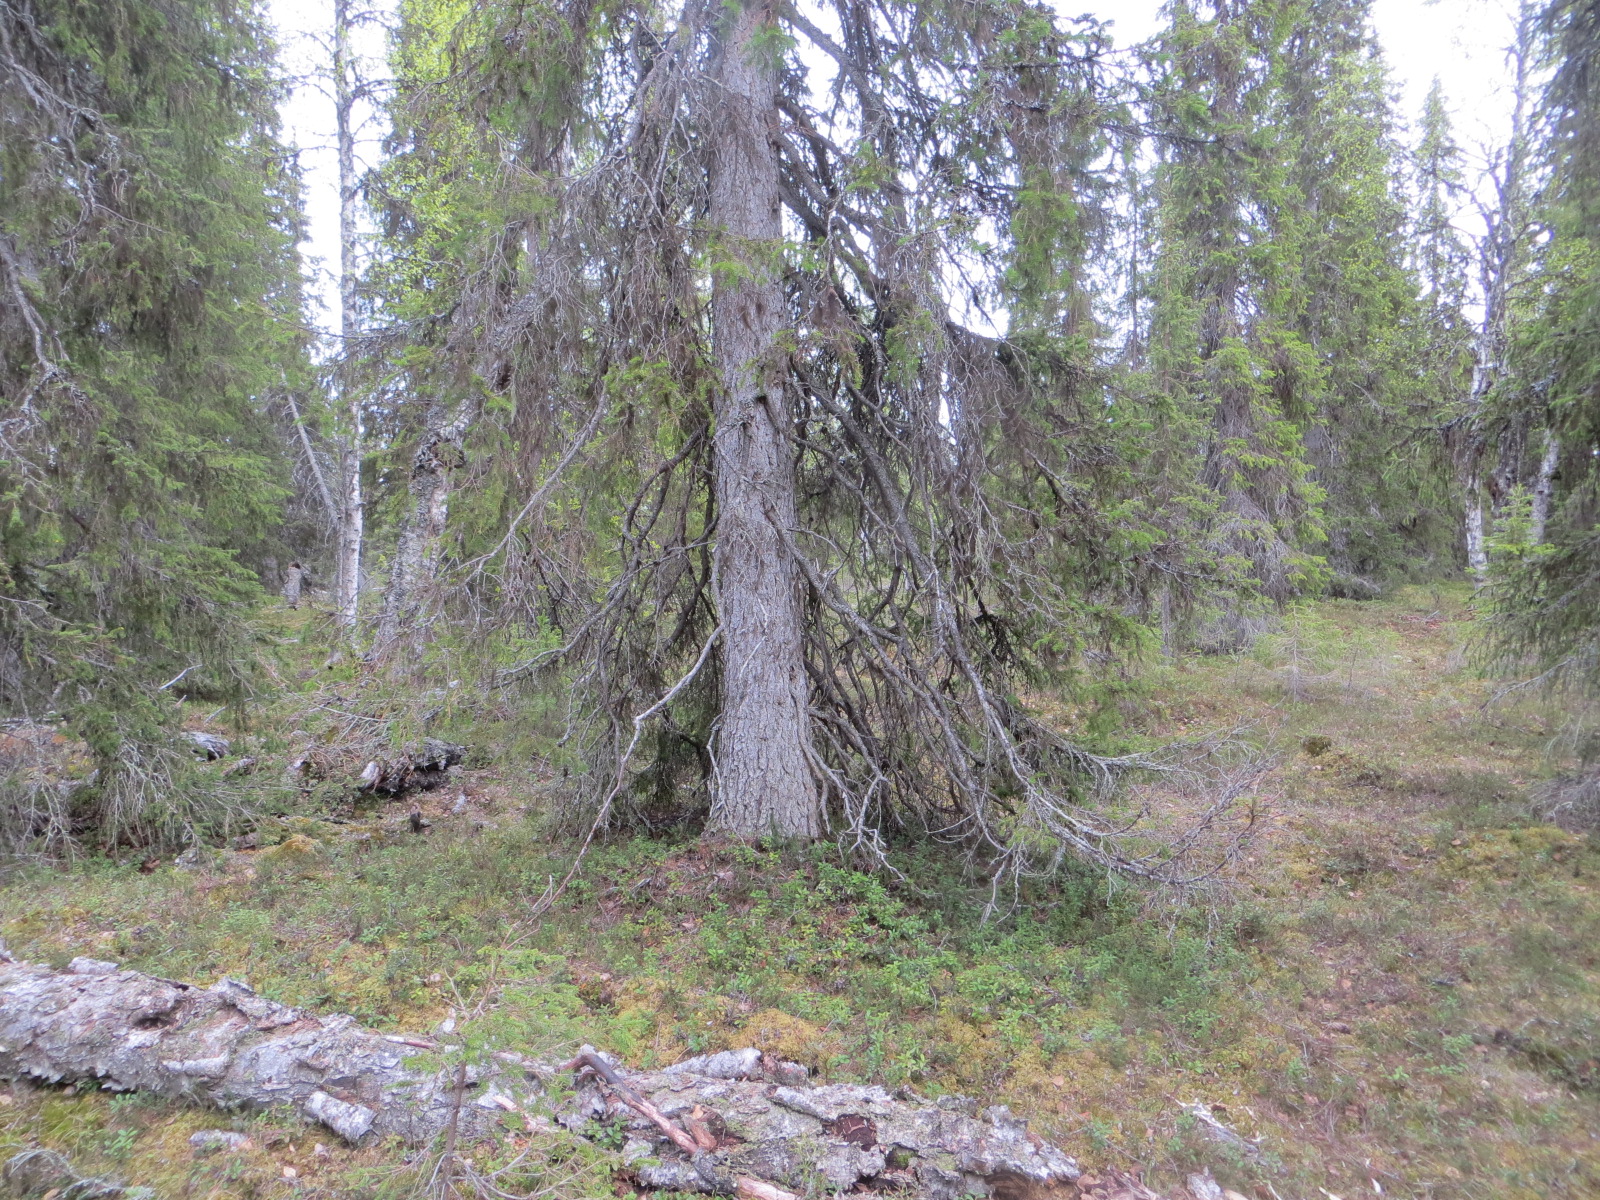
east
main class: Woodland
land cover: Spruce dominated mixed woodland
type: boreal forest
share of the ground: 50 - 75 %
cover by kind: coniferous forest trees 50 %, shrubs 25 %, broadleaved forest trees 20 %, lichens and mosses 5 %
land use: Semi-natural and natural areas not in use
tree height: > 5 m
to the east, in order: Spruce dominated mixed woodland; Ponds and wetlands; Spruce dominated mixed woodland; Inland marshes; Spruce dominated mixed woodland
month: June
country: FI
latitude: 67.9613
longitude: 26.1758
